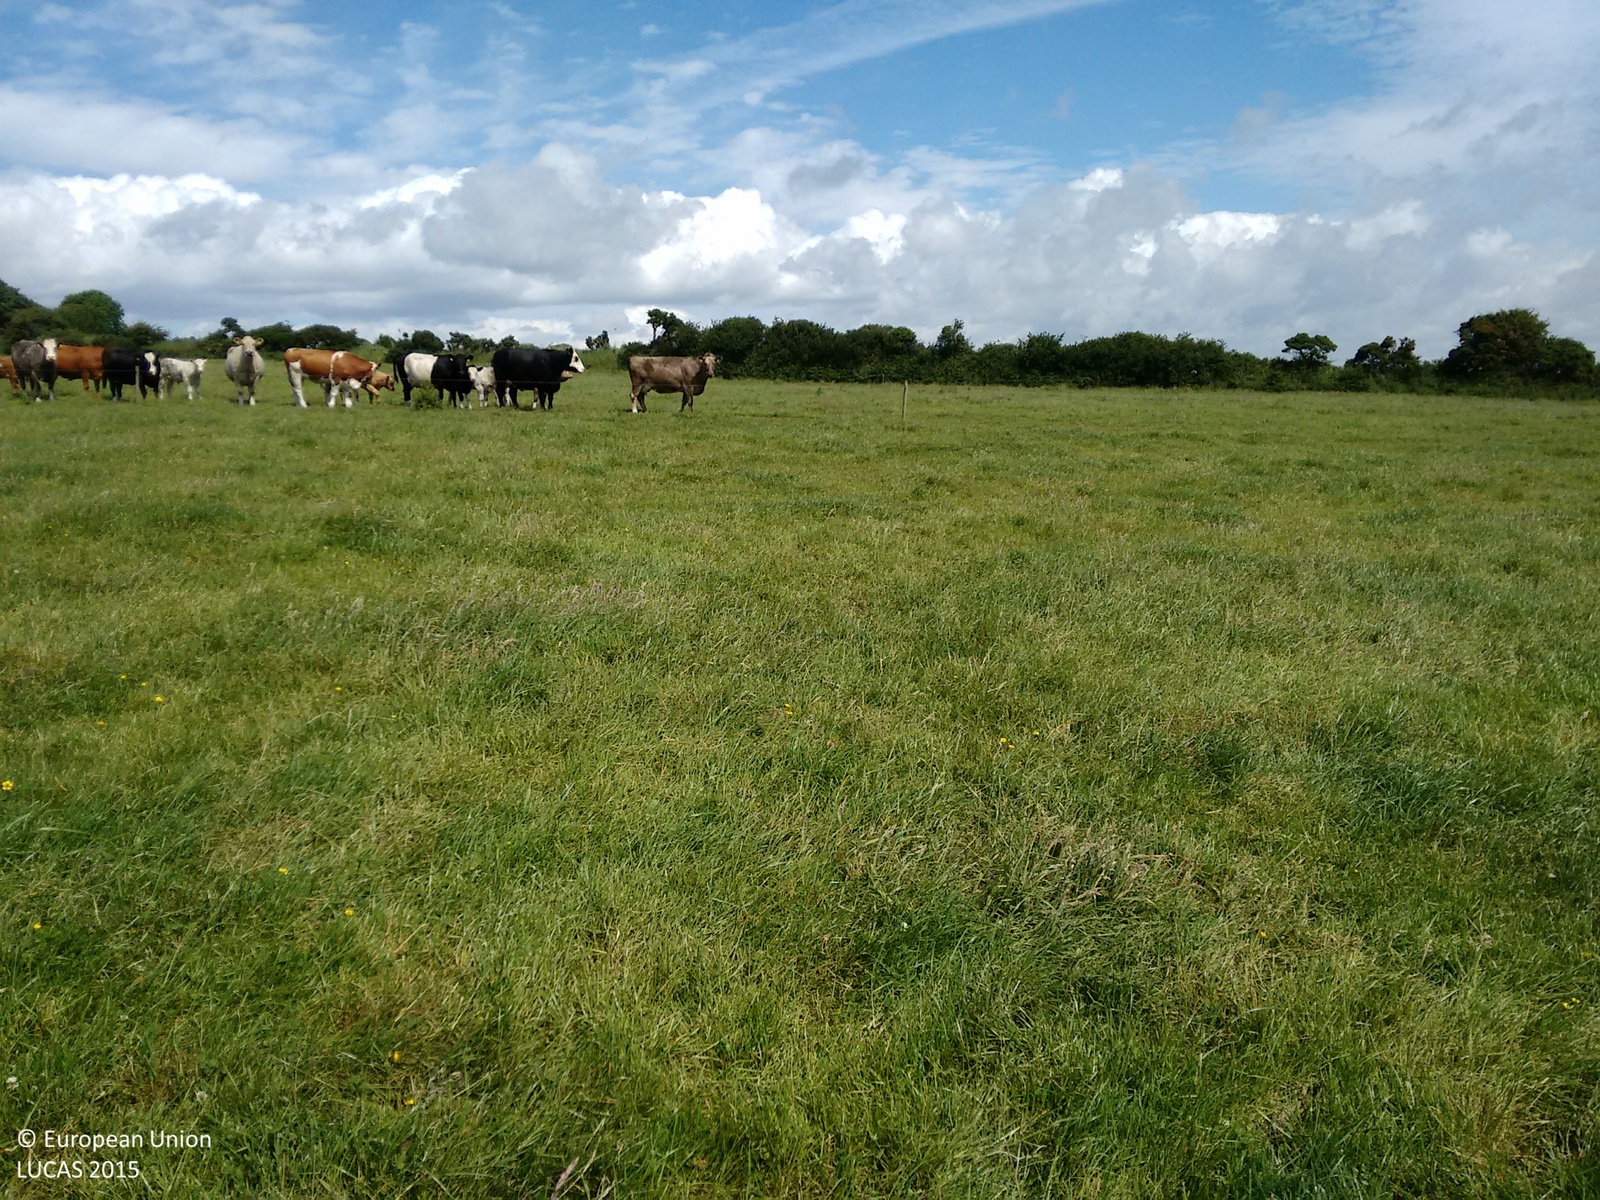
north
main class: Grassland
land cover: Grassland without tree/shrub cover
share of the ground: > 75 %
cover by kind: herbaceous plants 100 %
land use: Agriculture (excluding fallow land and kitchen gardens)
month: June
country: IE
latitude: 52.2162
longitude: -7.0498
